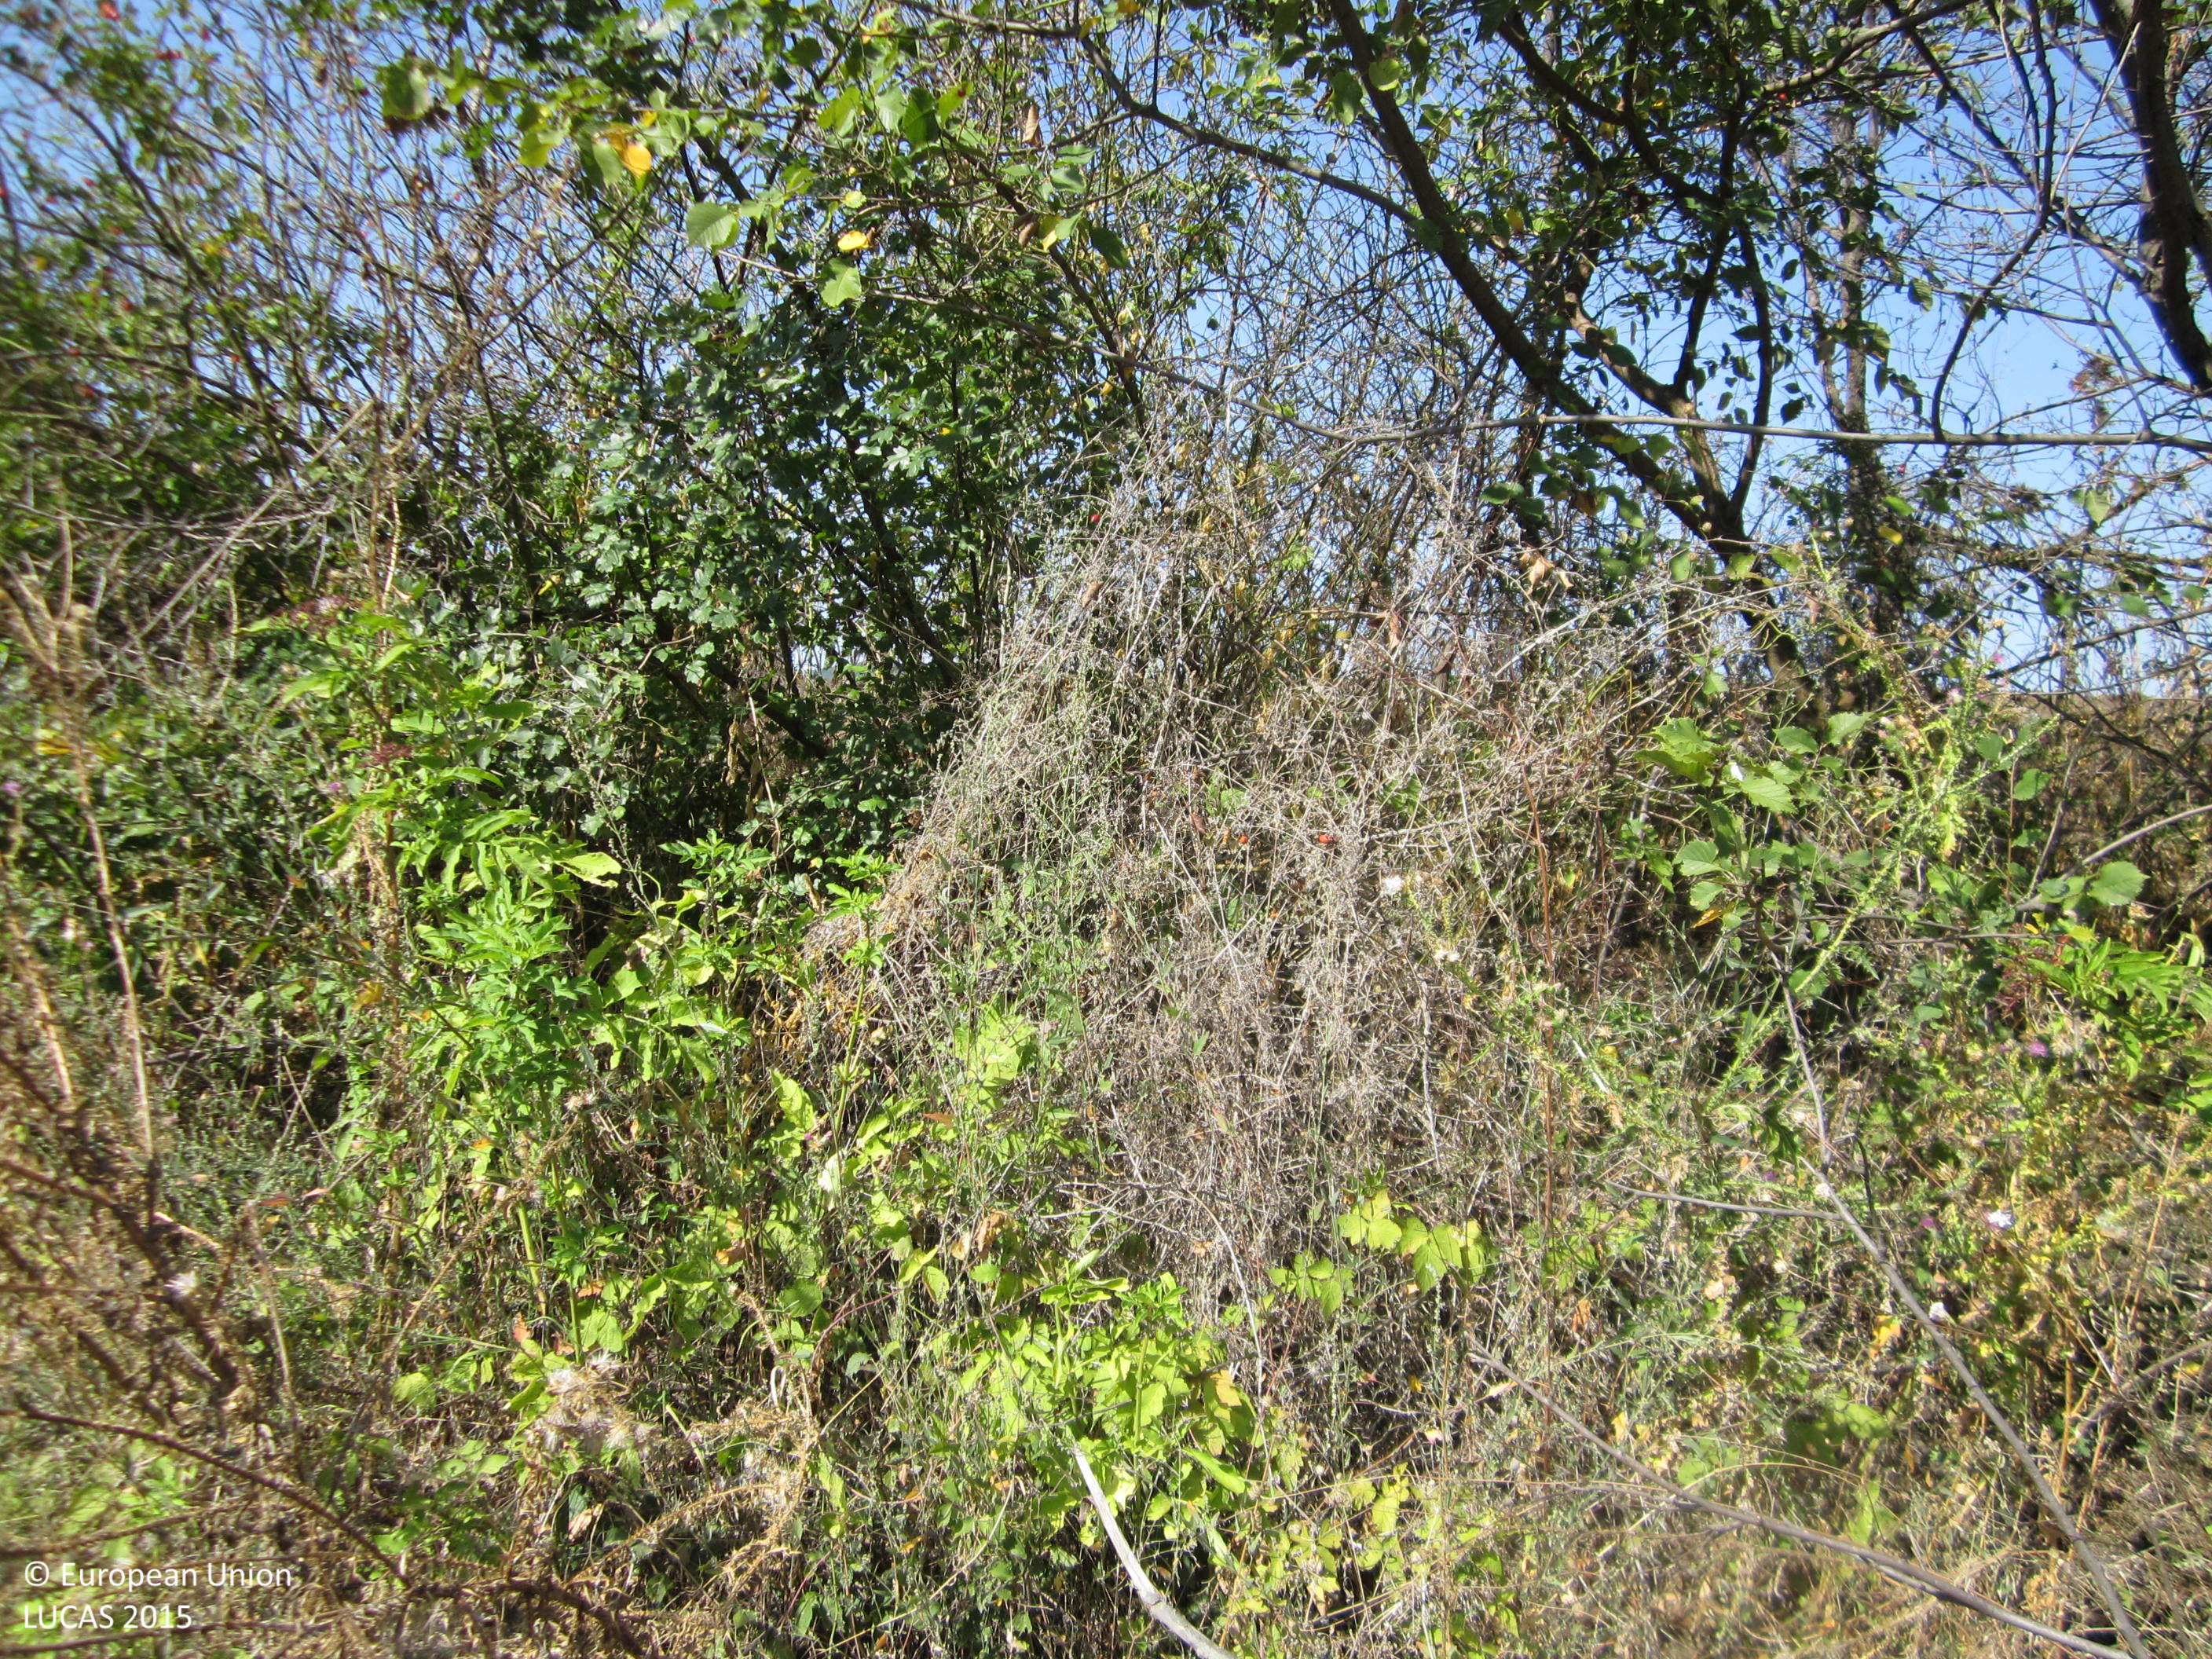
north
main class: Shrubland
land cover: Shrubland with sparse tree cover
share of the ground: 25 - 50 %
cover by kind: herbaceous plants 55 %, shrubs 40 %, broadleaved forest trees 5 %
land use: Semi-natural and natural areas not in use
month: September
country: BG
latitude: 42.7197
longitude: 27.3971
